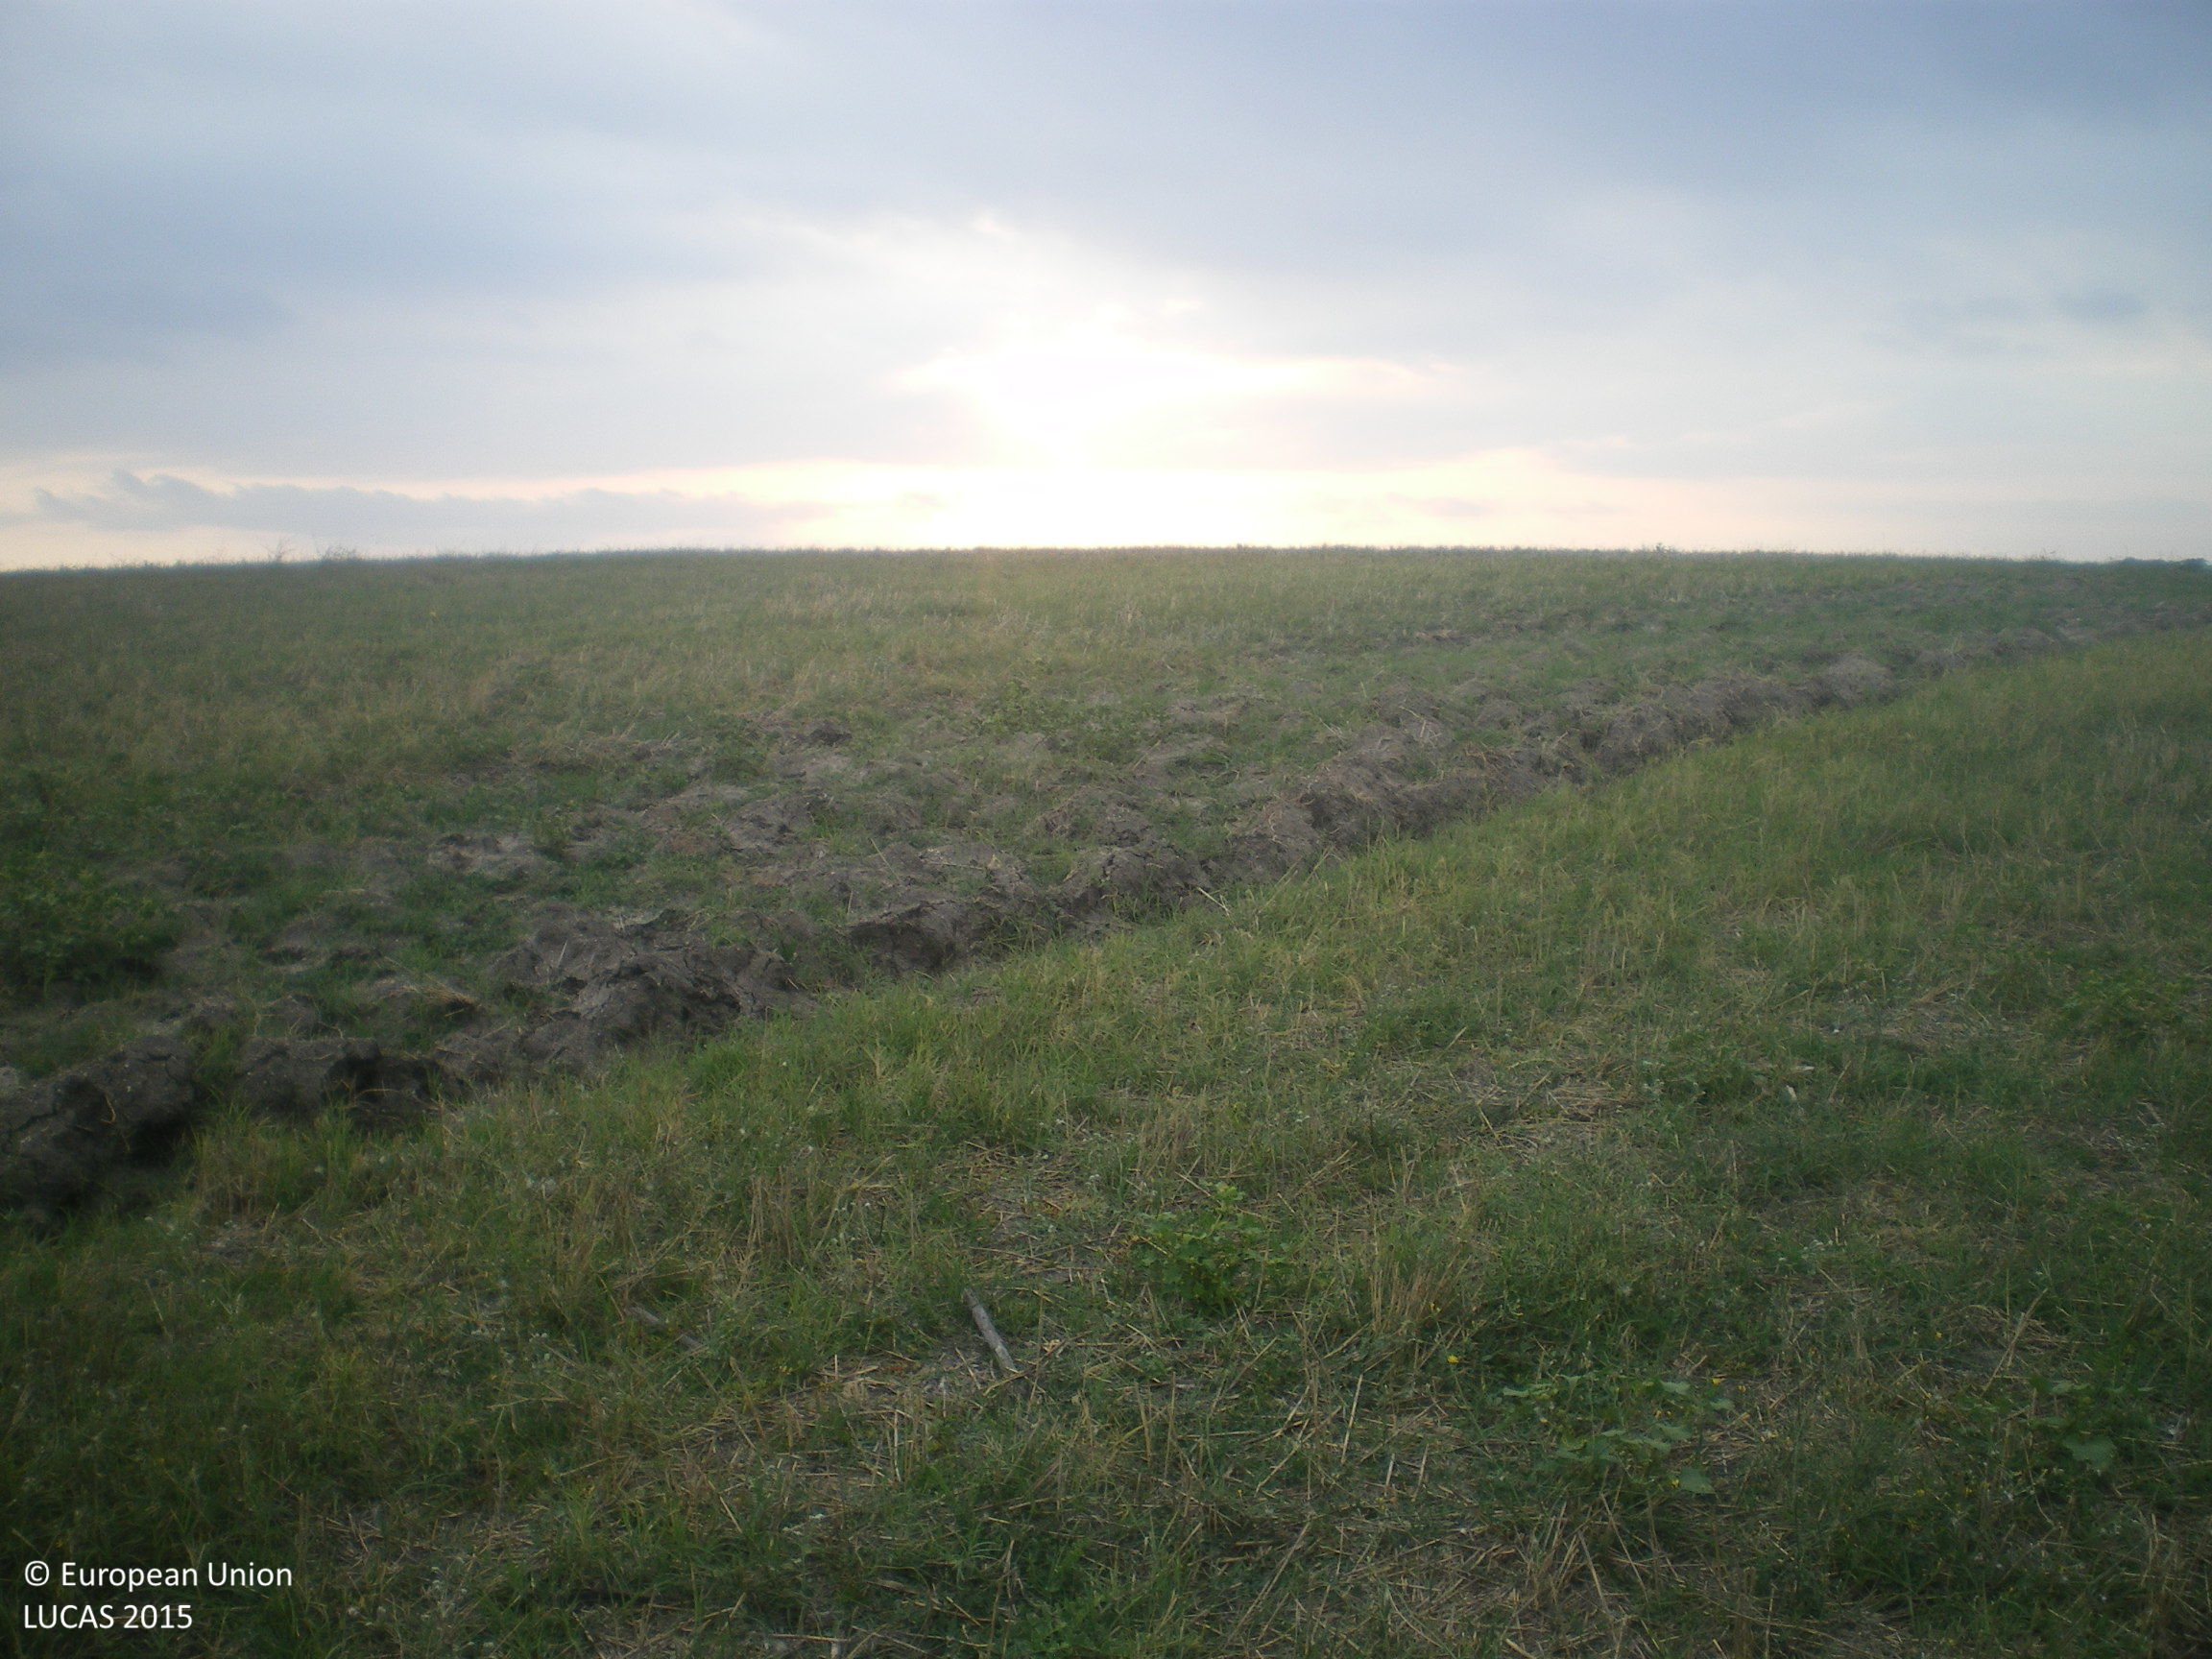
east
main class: Cropland
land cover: Barley
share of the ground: < 10 %
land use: Agriculture (excluding fallow land and kitchen gardens)
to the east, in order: Barley
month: September
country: BG
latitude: 42.0456
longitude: 25.8131
